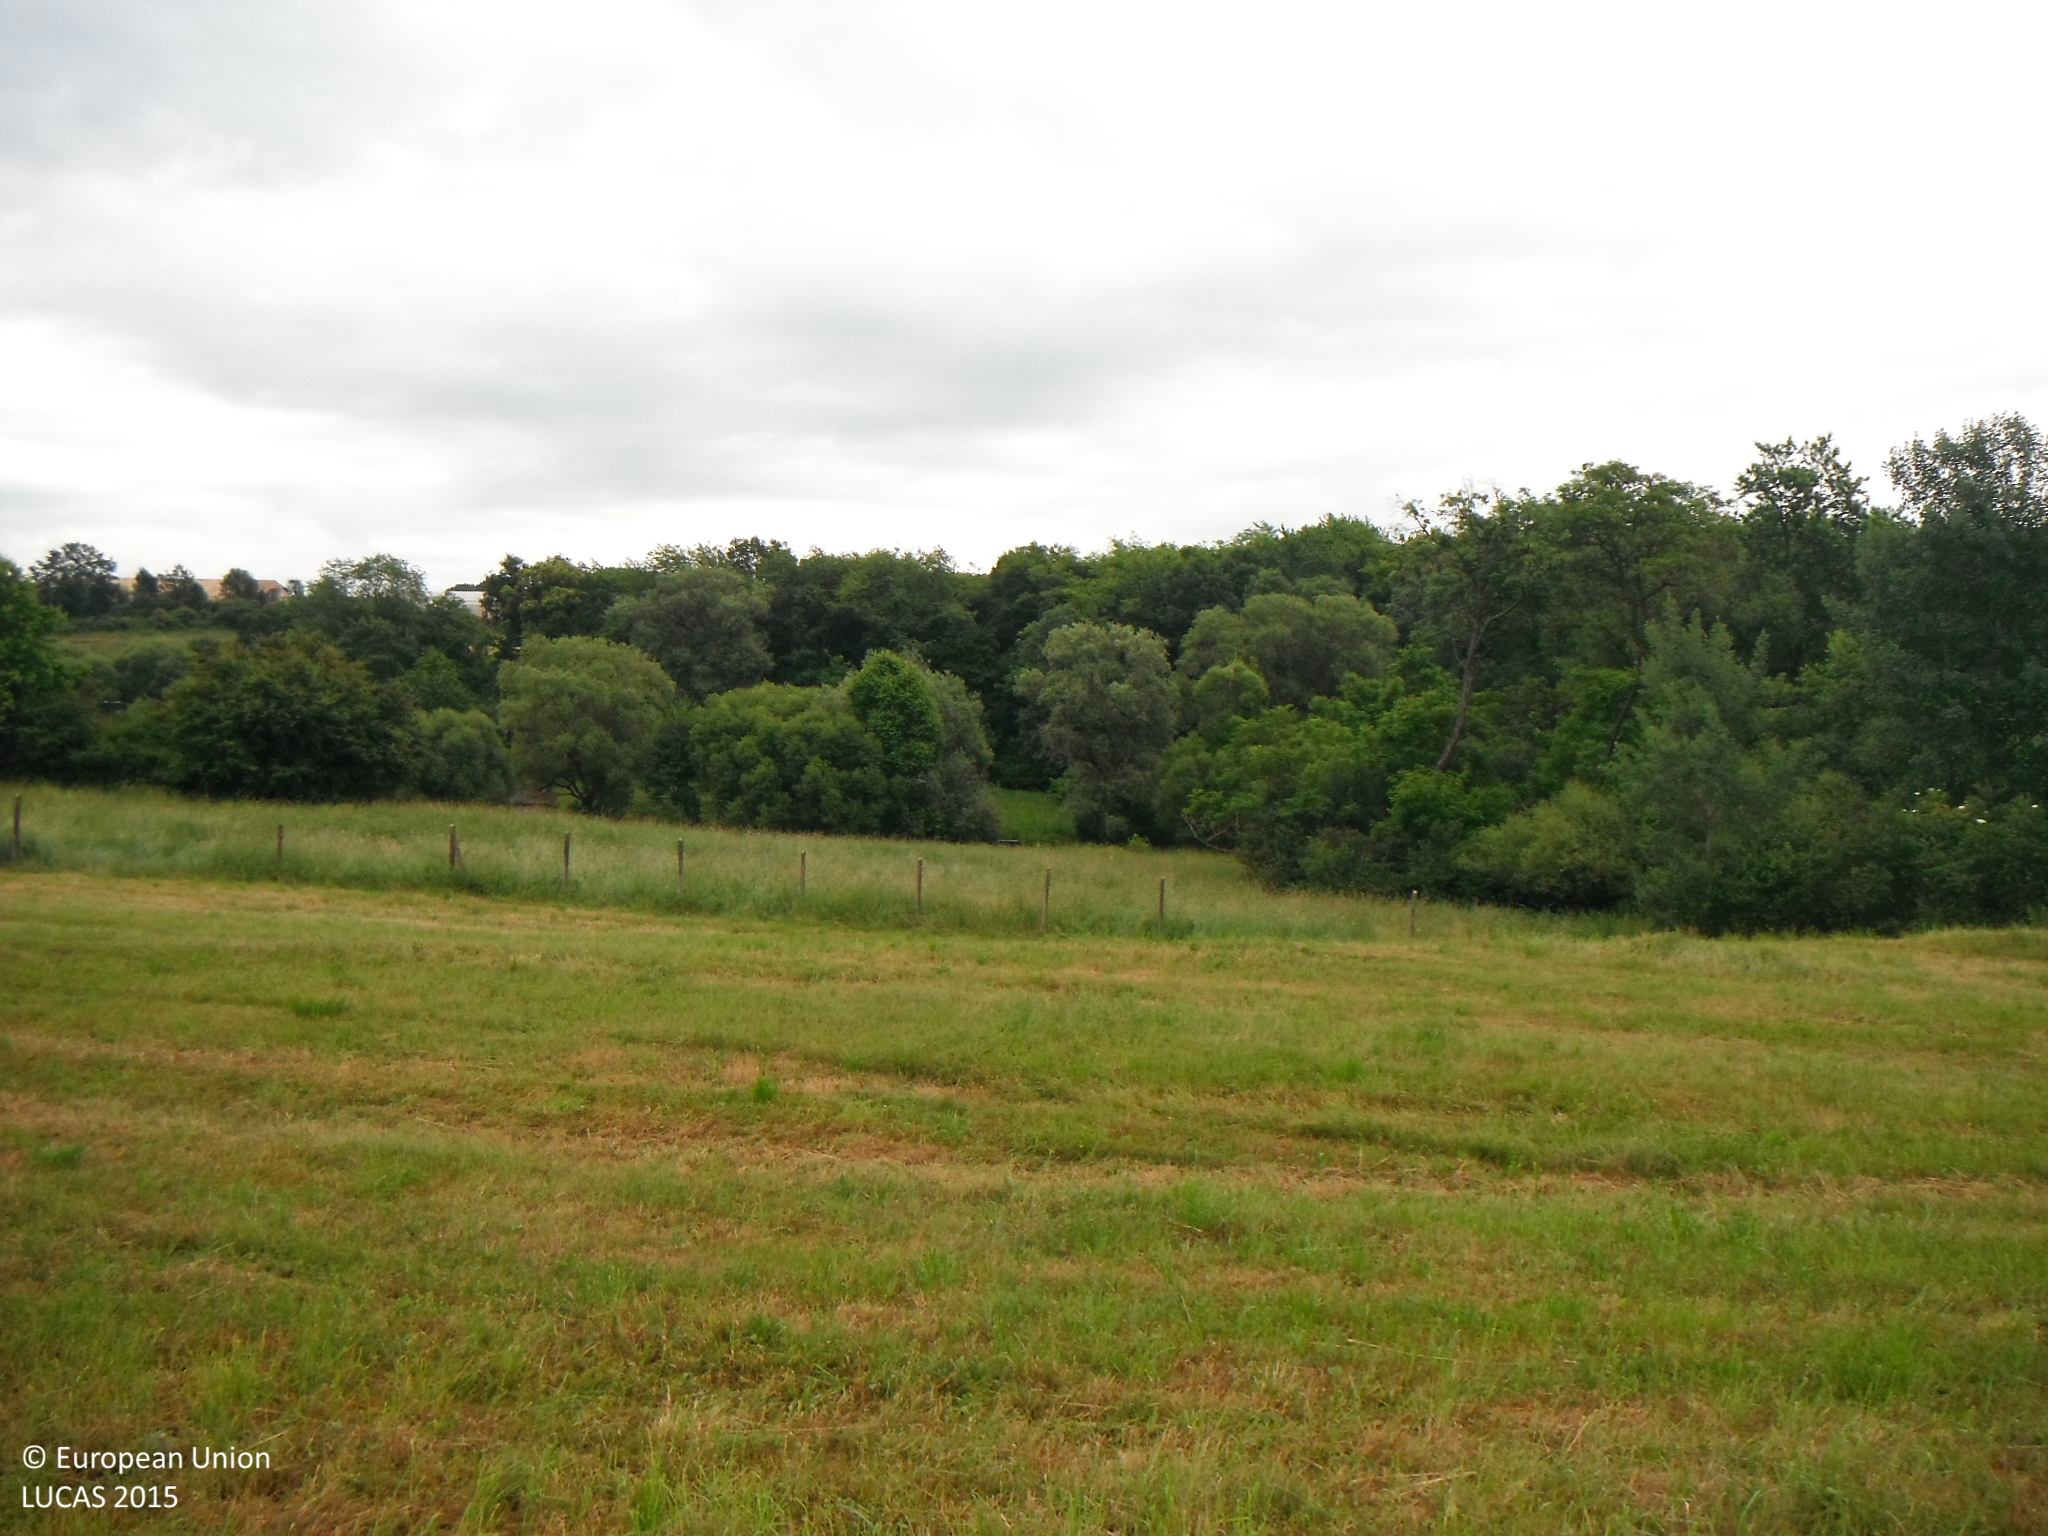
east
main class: Grassland
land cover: Grassland without tree/shrub cover
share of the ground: > 75 %
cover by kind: herbaceous plants 100 %
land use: Agriculture (excluding fallow land and kitchen gardens)
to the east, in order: Grassland without tree/shrub cover; Fences; Grassland without tree/shrub cover; Broadleaved woodland; Spontaneously vegetated surfaces; Broadleaved woodland; Rivers and streams; Broadleaved woodland; Grassland without tree/shrub cover; Electric lines; Grassland without tree/shrub cover
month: June
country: SK
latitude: 48.3308
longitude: 19.3710
